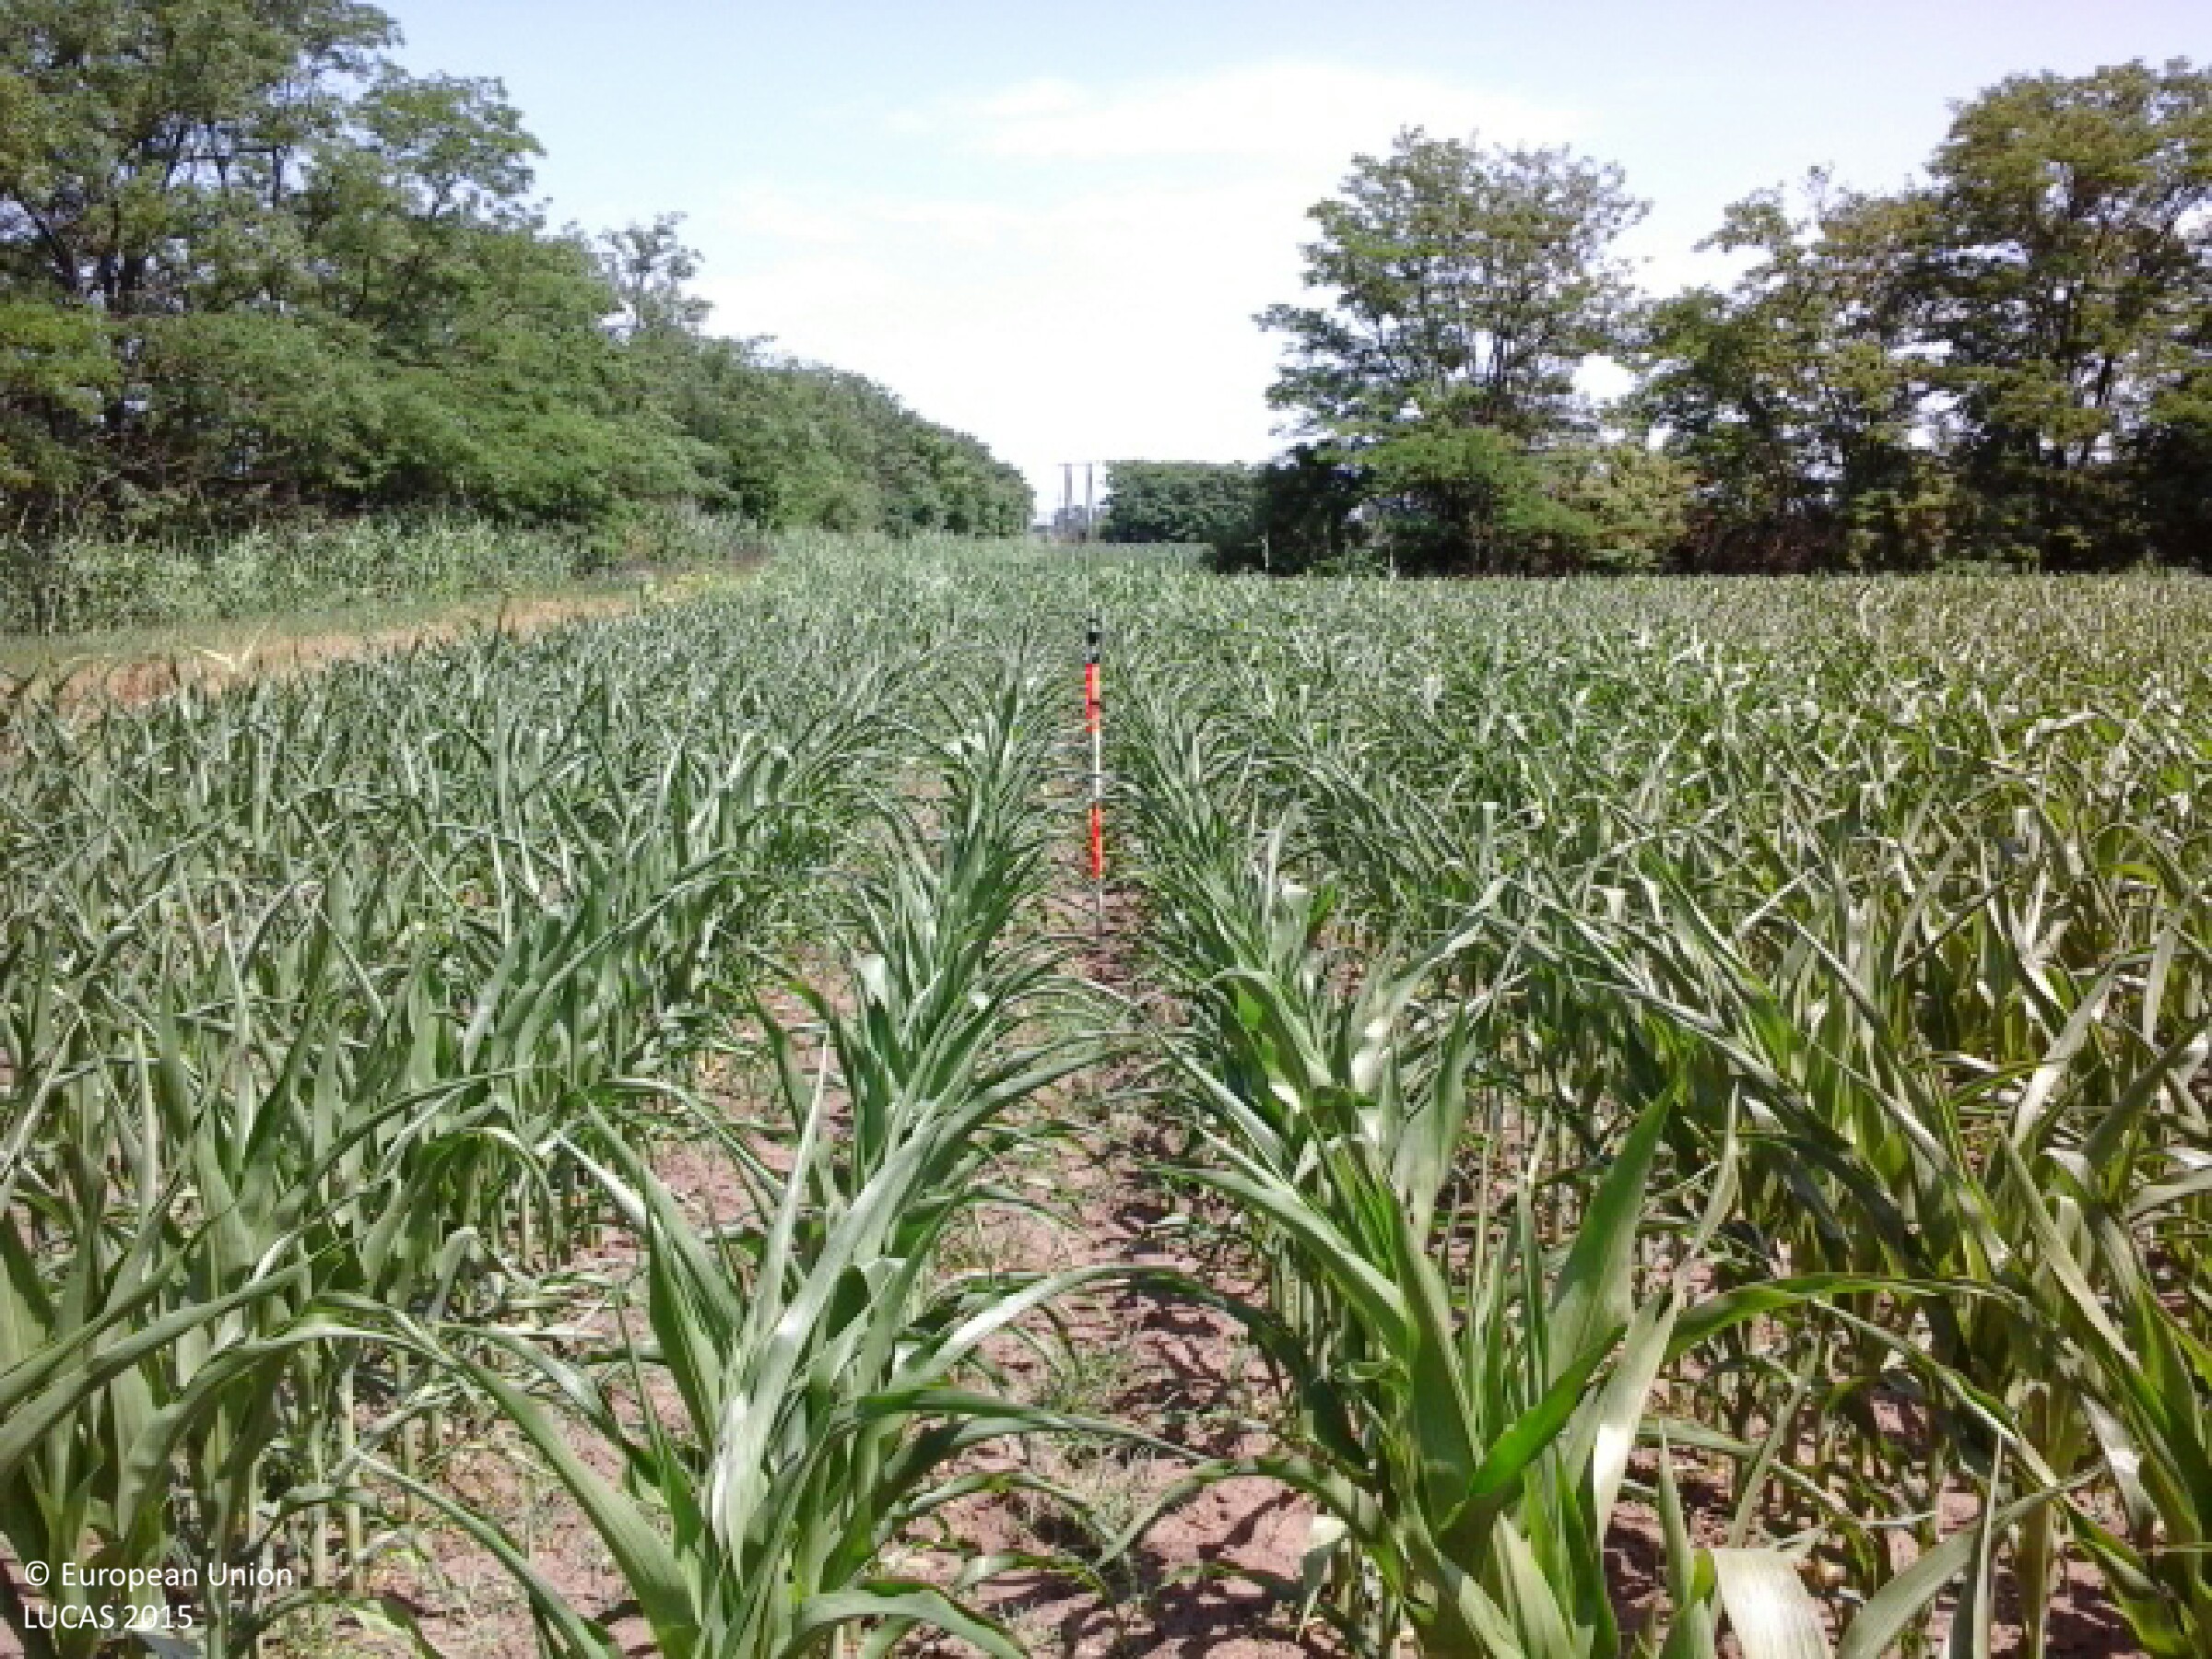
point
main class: Cropland
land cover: Maize
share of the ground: 50 - 75 %
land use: Agriculture (excluding fallow land and kitchen gardens)
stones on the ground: < 10 %
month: June
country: HU
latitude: 47.8539
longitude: 21.6879
